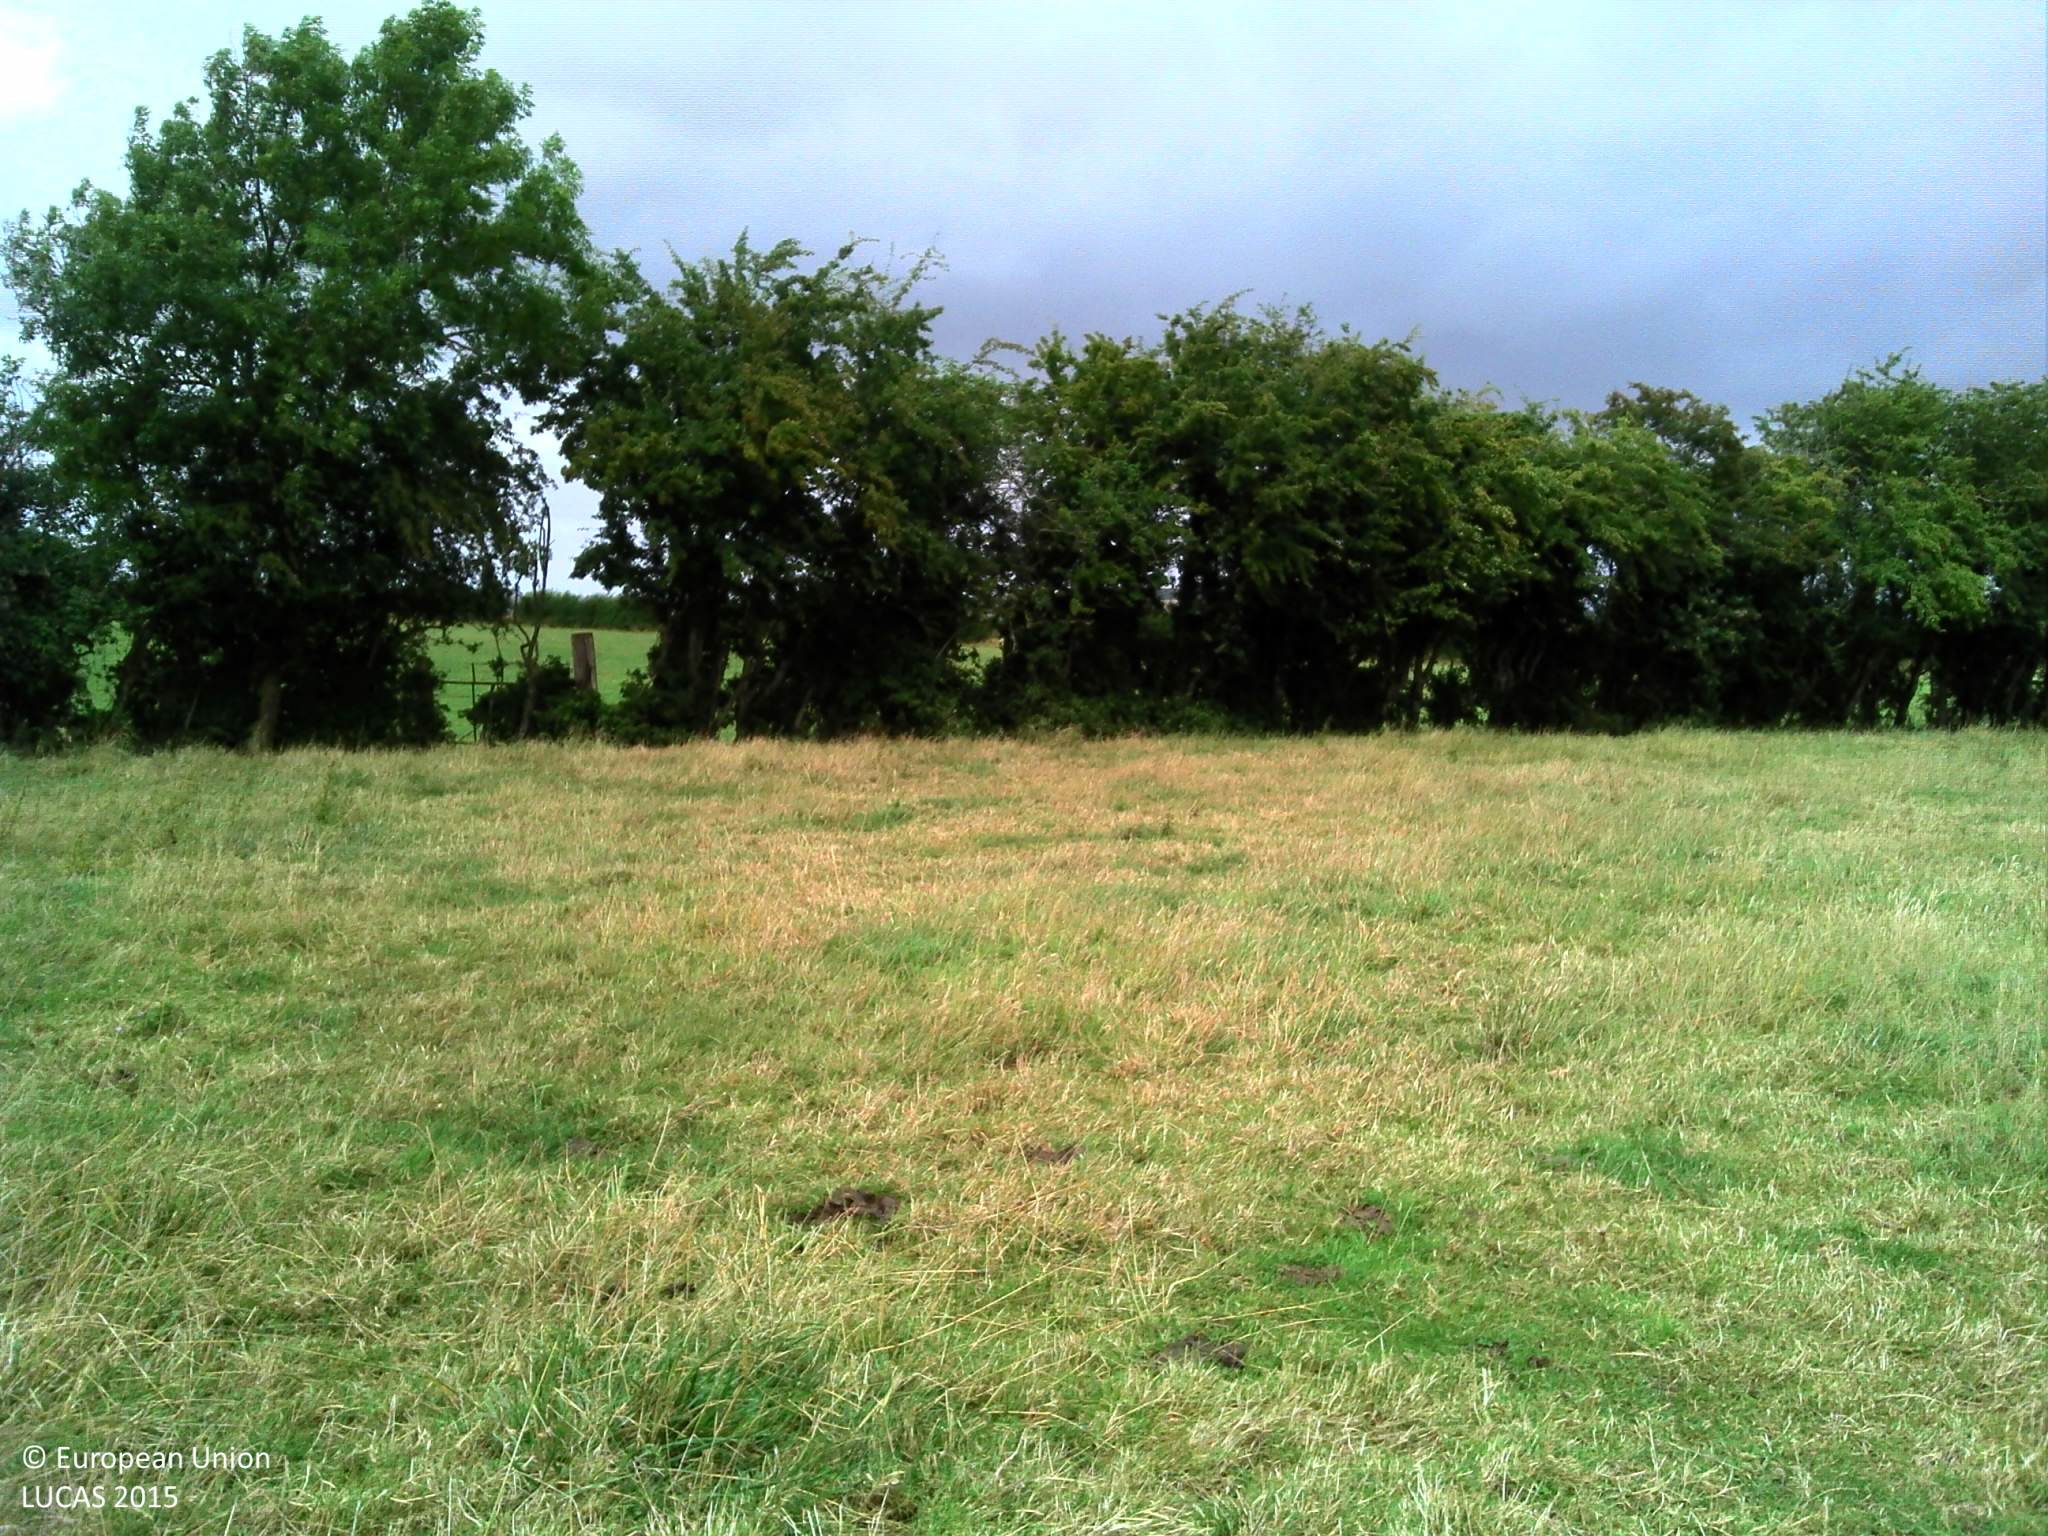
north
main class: Grassland
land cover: Grassland without tree/shrub cover
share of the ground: > 75 %
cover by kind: herbaceous plants 100 %
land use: Agriculture (excluding fallow land and kitchen gardens)
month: July
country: FR
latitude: 50.6709
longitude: 2.1320
